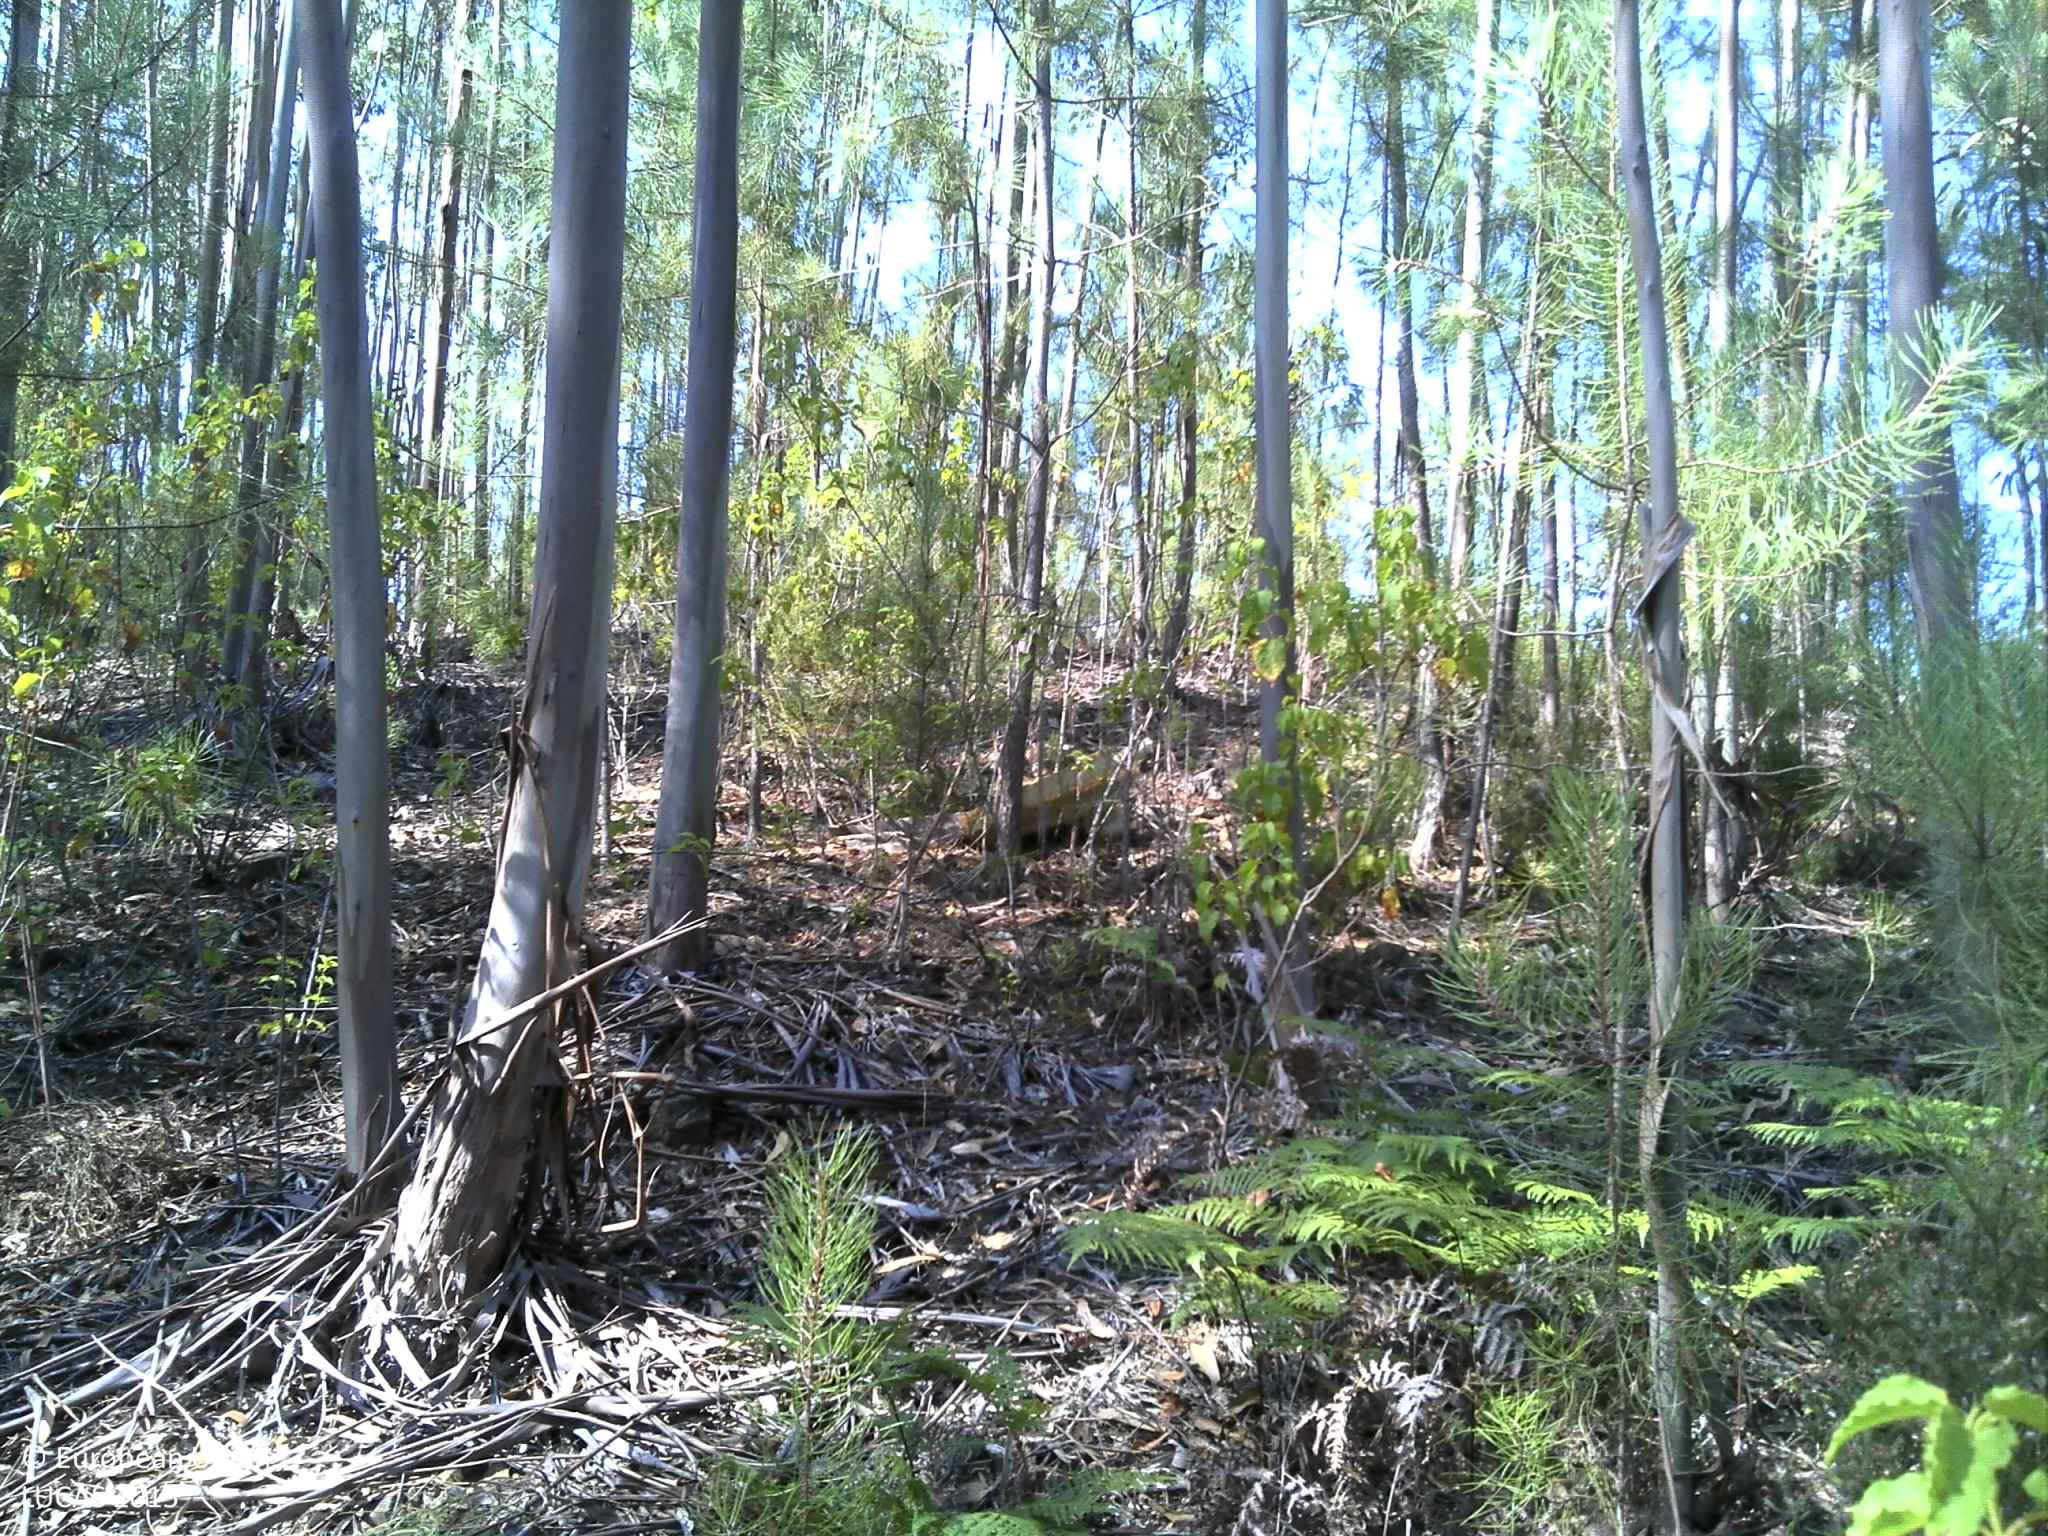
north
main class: Woodland
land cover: Broadleaved woodland
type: exotic forest
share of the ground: 25 - 50 %
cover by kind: unconsolidated bare surface 45 %, broadleaved forest trees 30 %, shrubs 20 %, coniferous forest trees 5 %
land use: Forestry
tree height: > 5 m
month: June
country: PT
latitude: 39.9613
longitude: -8.0623
